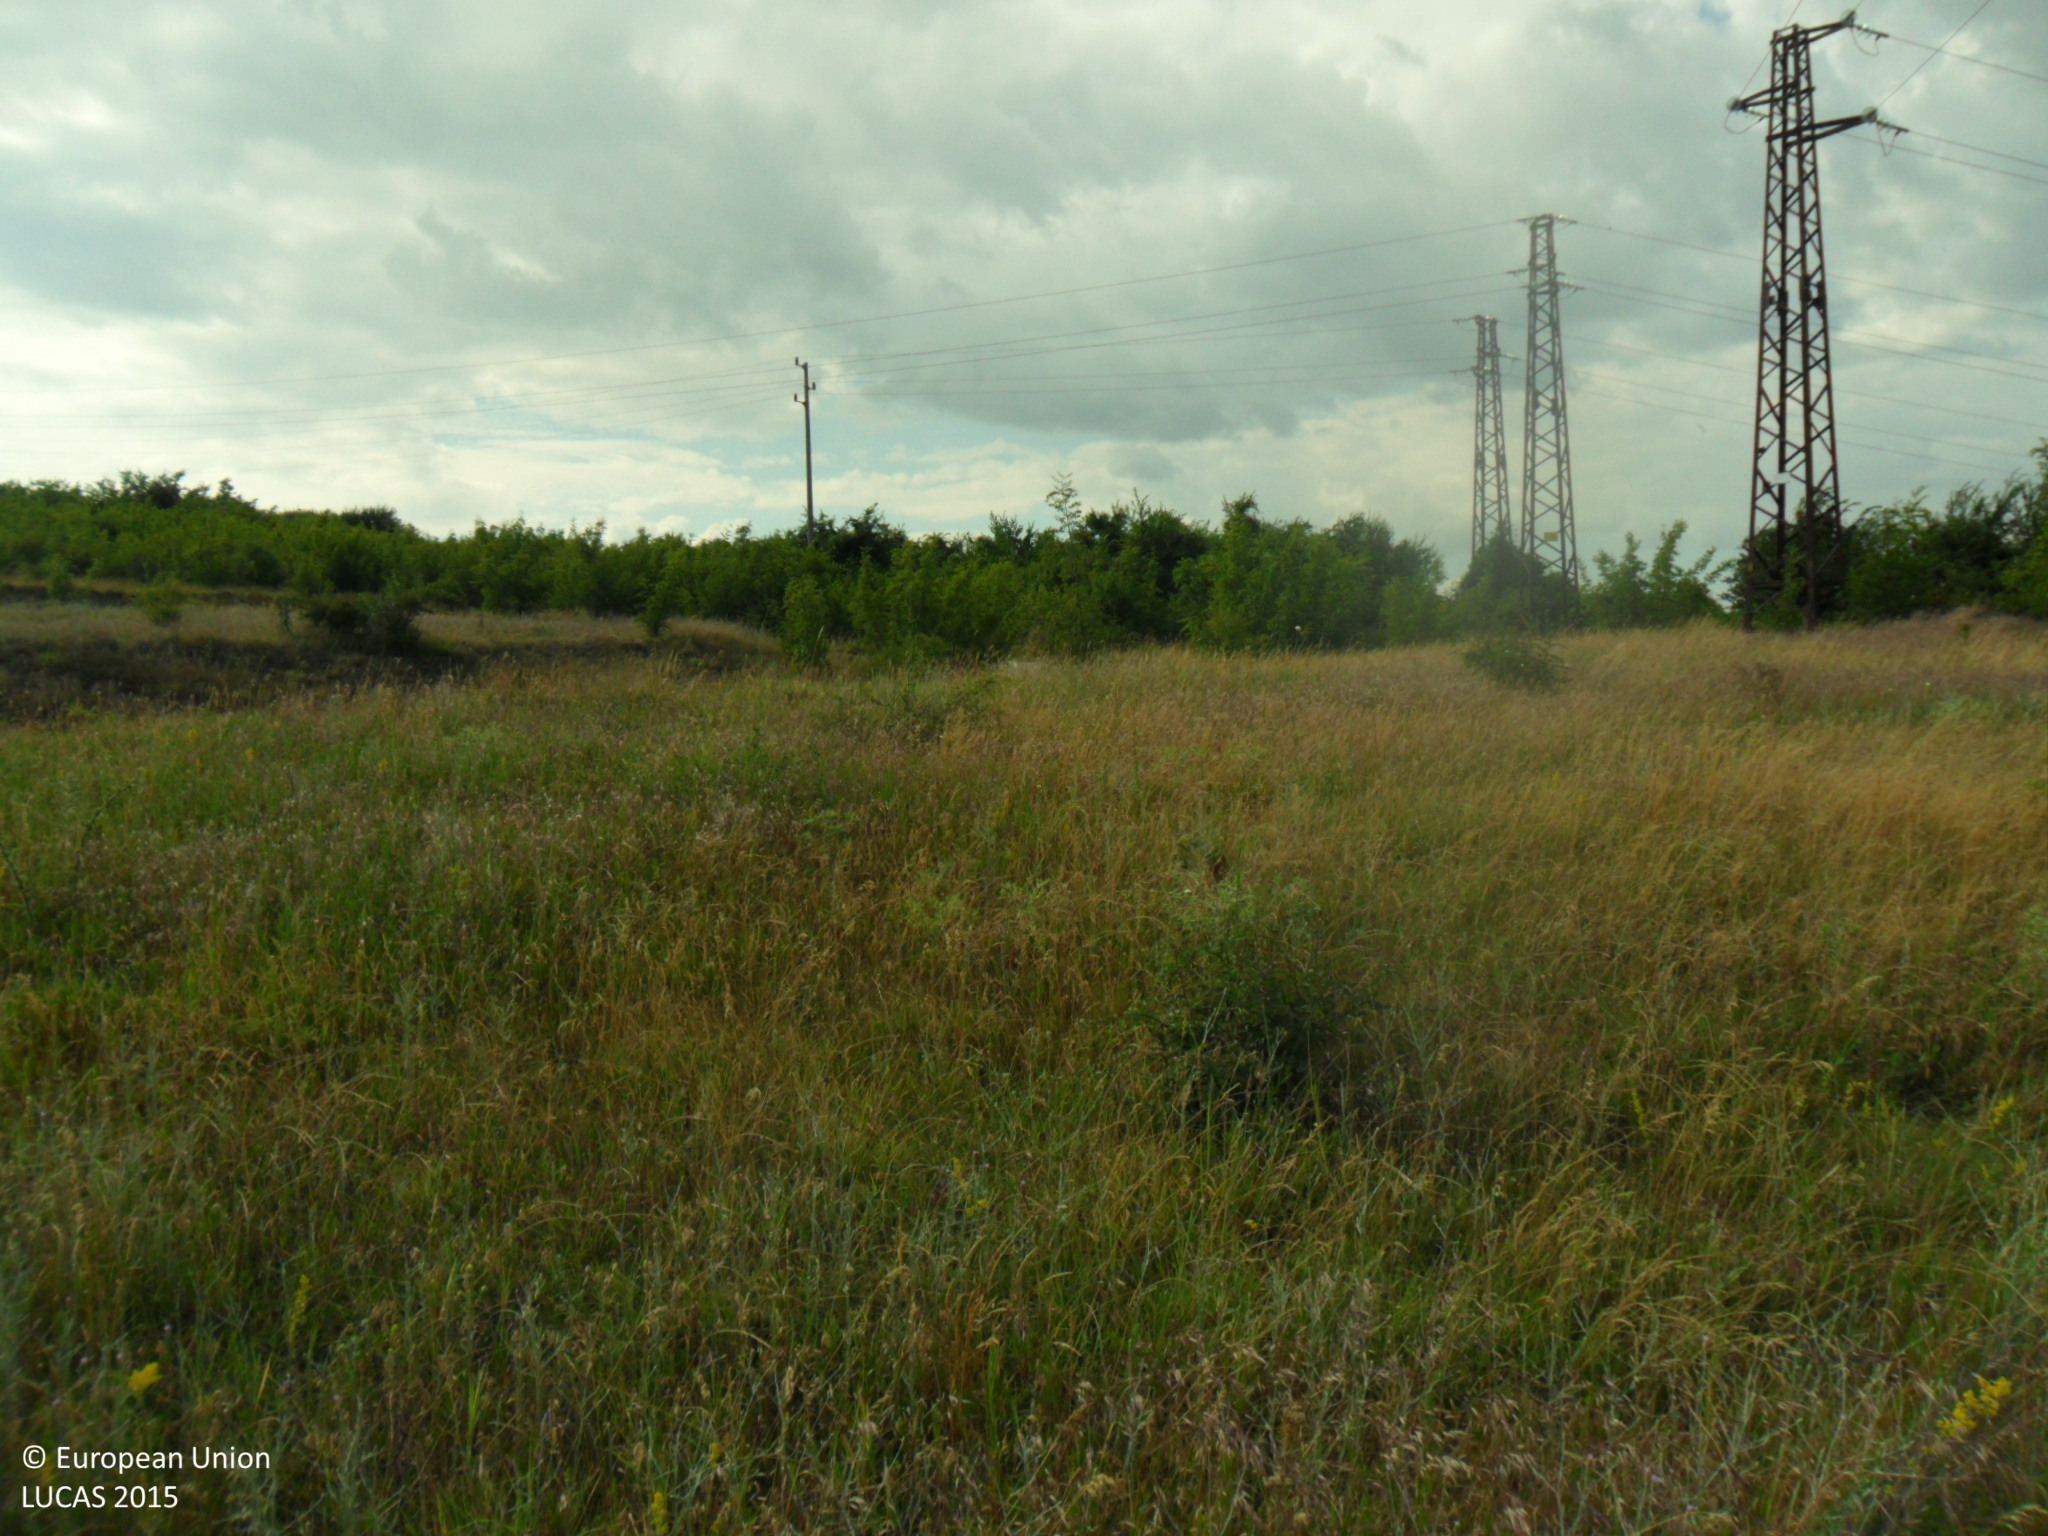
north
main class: Grassland
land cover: Grassland without tree/shrub cover
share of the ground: > 75 %
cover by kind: herbaceous plants 95 %, shrubs 5 %
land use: Agriculture (excluding fallow land and kitchen gardens)
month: June
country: BG
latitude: 43.1671
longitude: 26.8246
